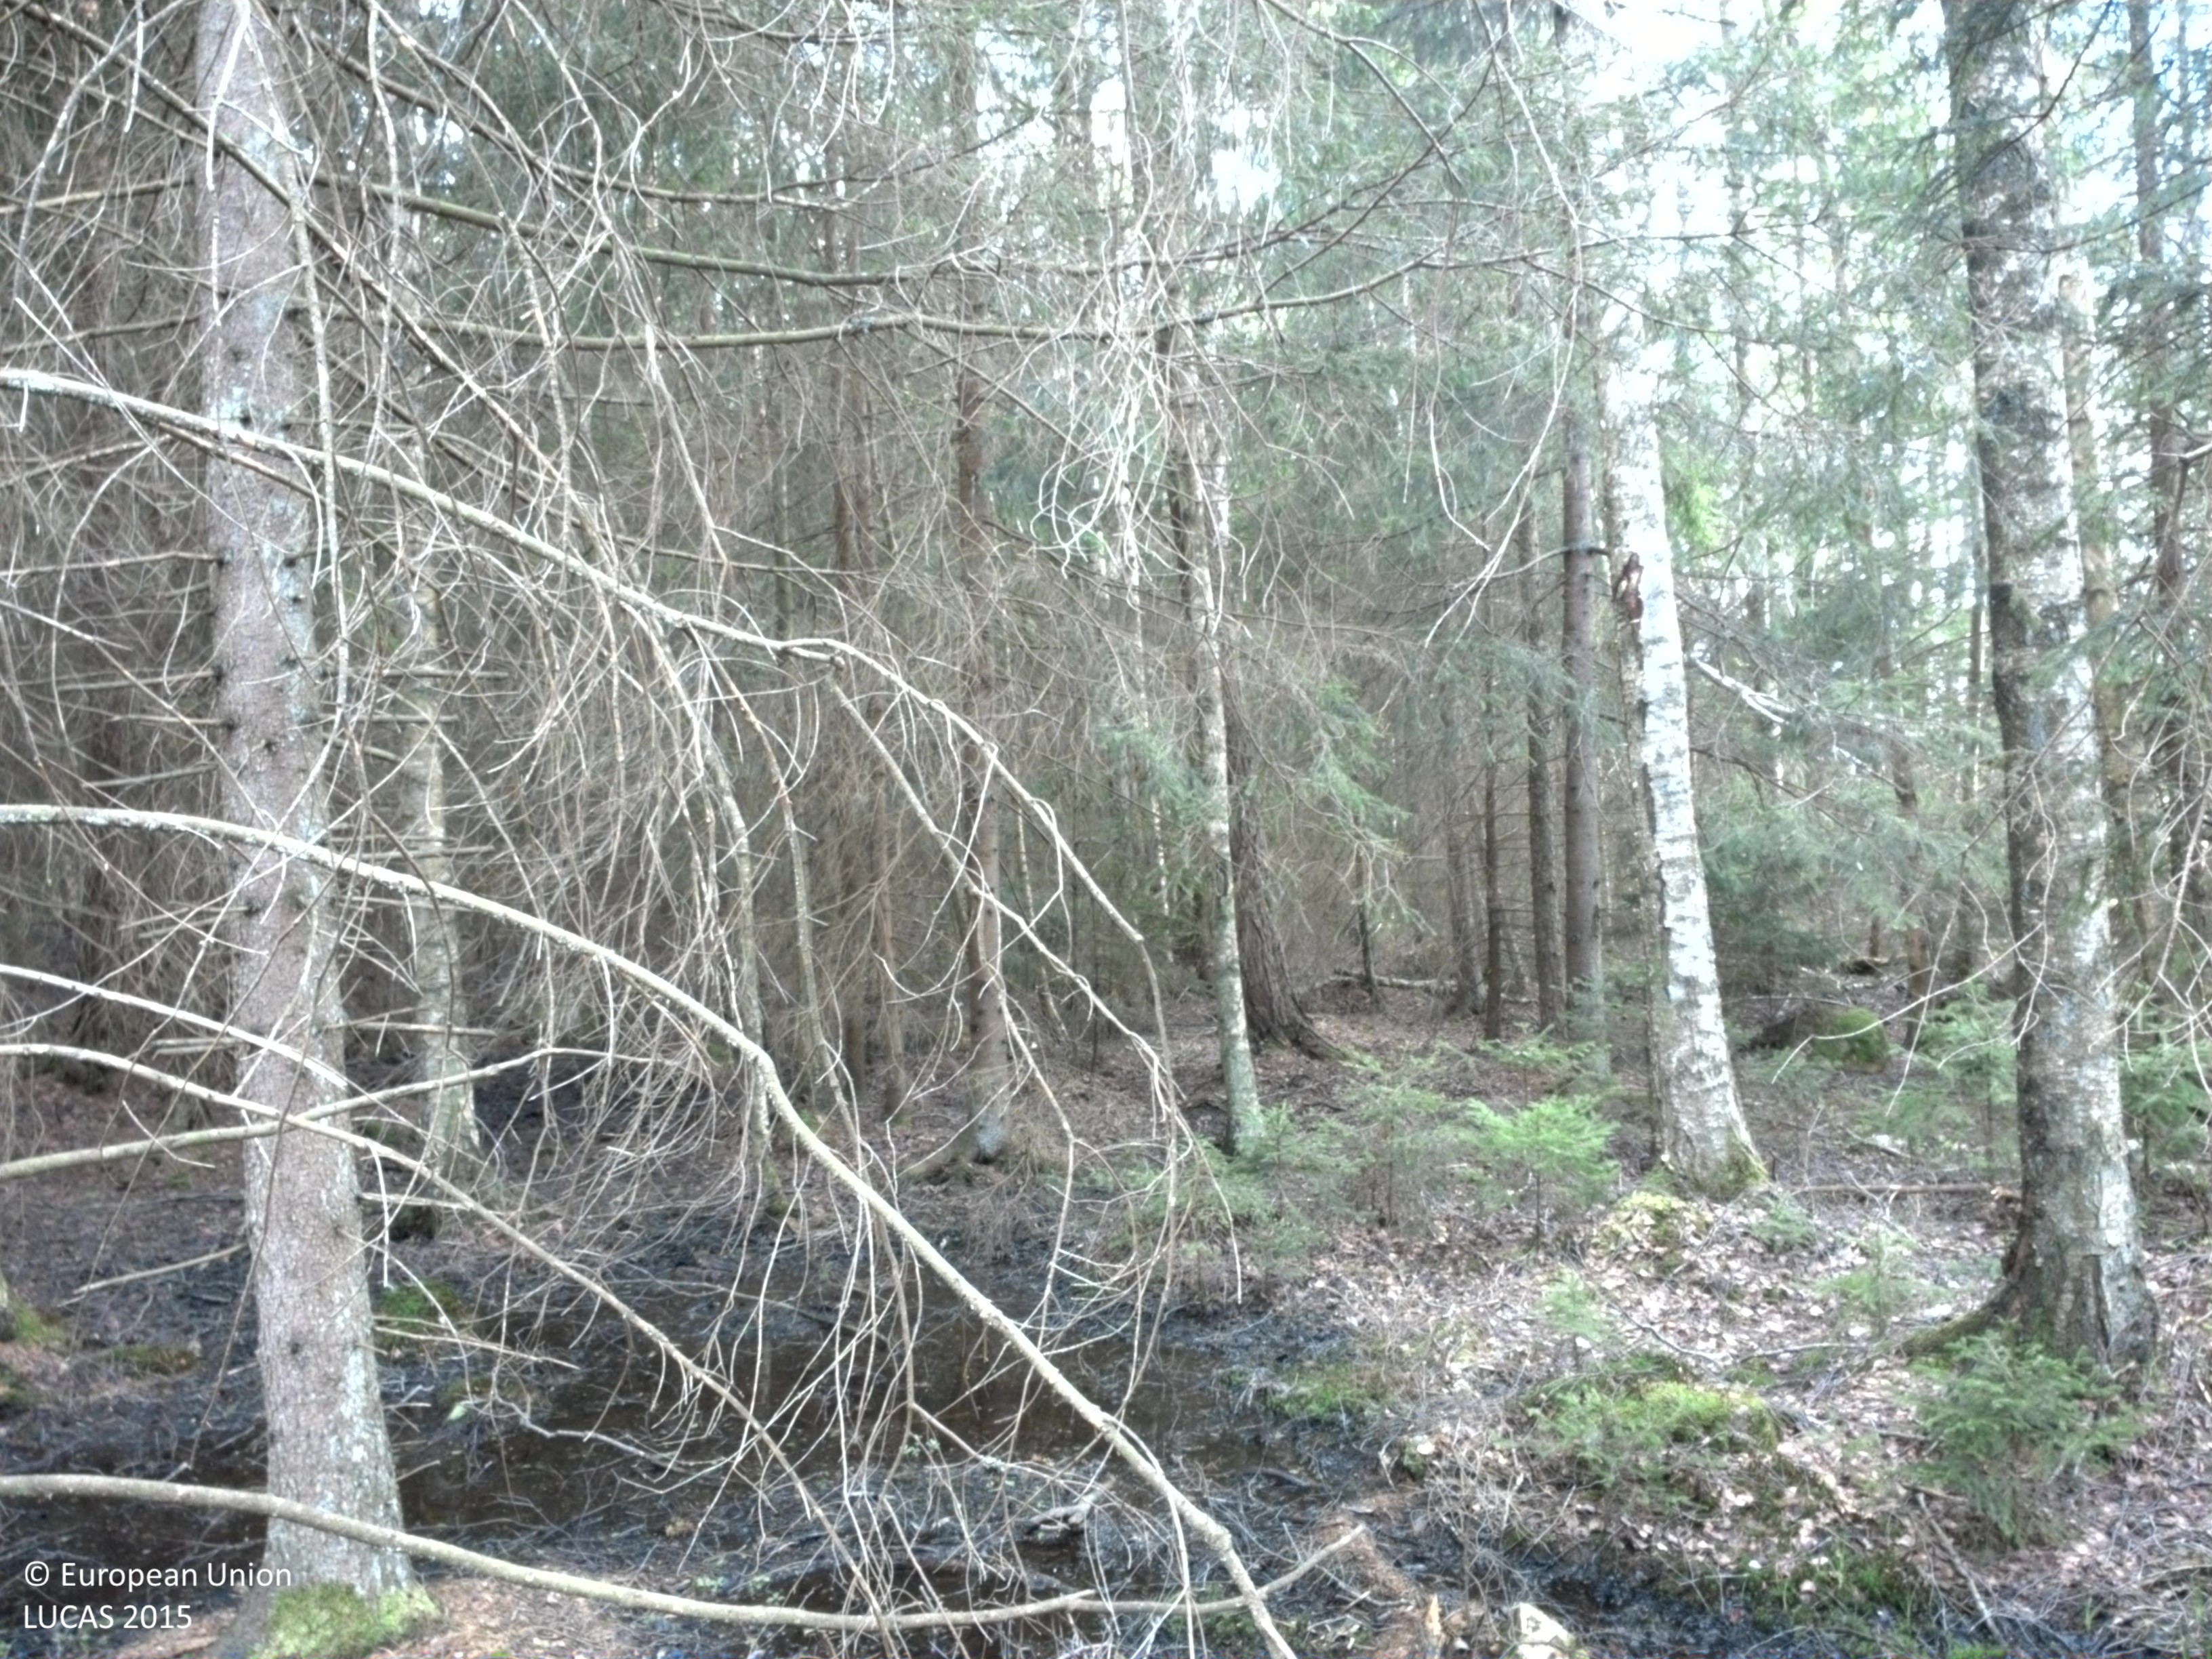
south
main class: Woodland
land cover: Spruce dominated coniferous woodland
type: boreal forest
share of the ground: > 75 %
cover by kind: coniferous forest trees 60 %, broadleaved forest trees 20 %, lichens and mosses 20 %
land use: Forestry
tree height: > 5 m
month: May
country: SE
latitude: 56.6464
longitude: 14.5799
